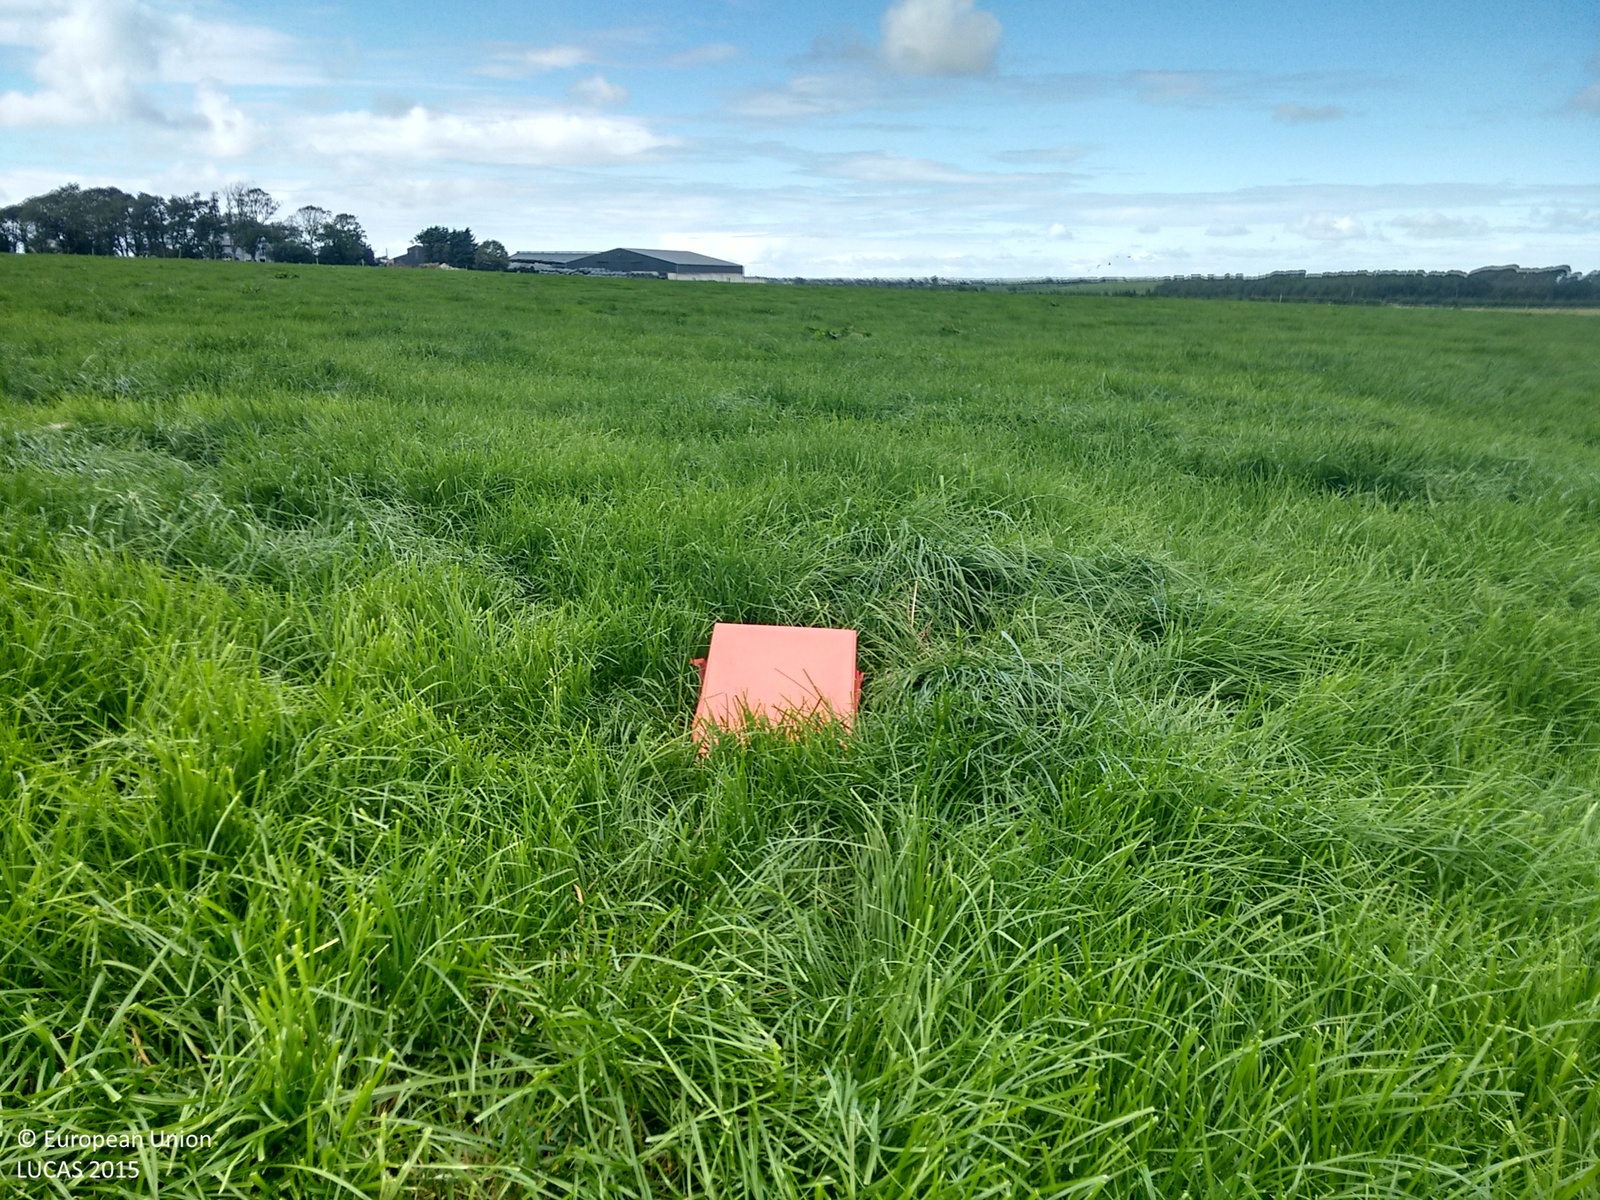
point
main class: Grassland
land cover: Grassland without tree/shrub cover
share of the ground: > 75 %
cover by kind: herbaceous plants 95 %, shrubs 5 %
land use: Agriculture (excluding fallow land and kitchen gardens)
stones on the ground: < 10 %
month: September
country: IE
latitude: 52.3482
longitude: -9.7230
